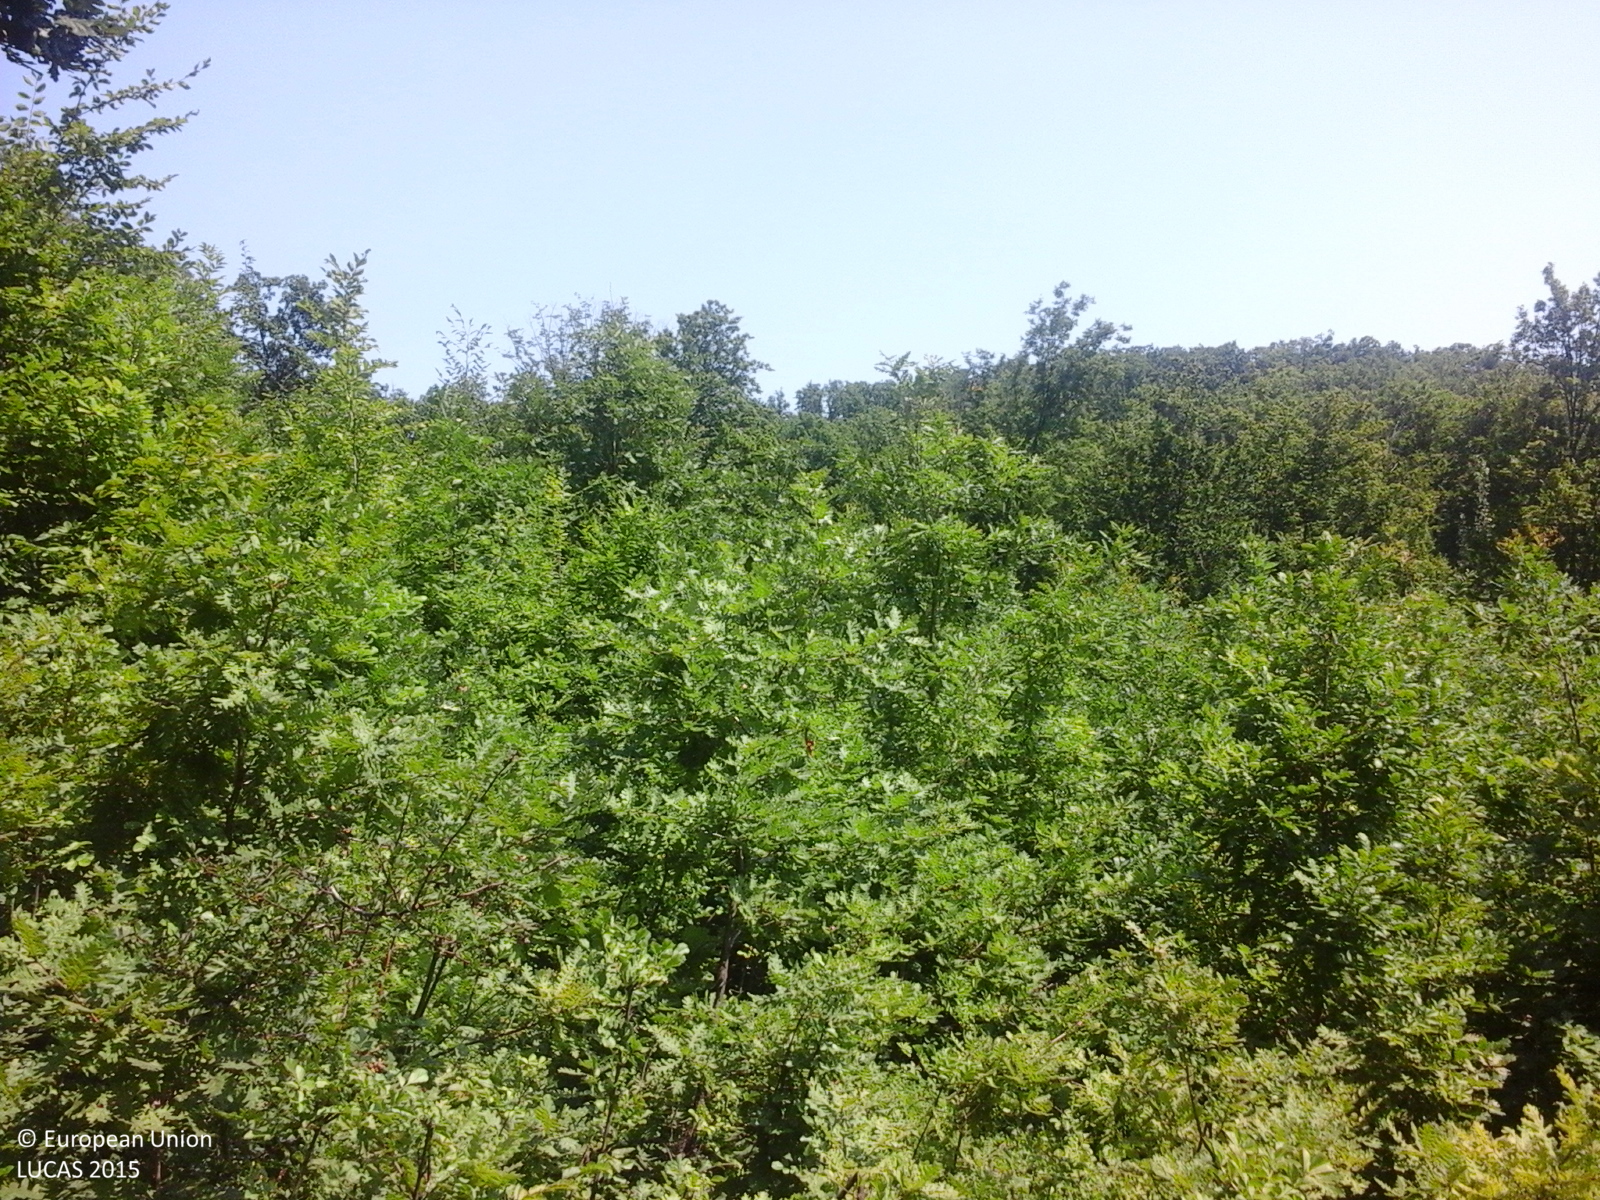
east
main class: Woodland
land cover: Broadleaved woodland
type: thermophilous deciduous forest
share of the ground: > 75 %
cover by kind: broadleaved forest trees 100 %
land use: Forestry
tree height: > 5 m
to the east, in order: Broadleaved woodland
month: July
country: RO
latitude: 44.8567
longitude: 25.0556
